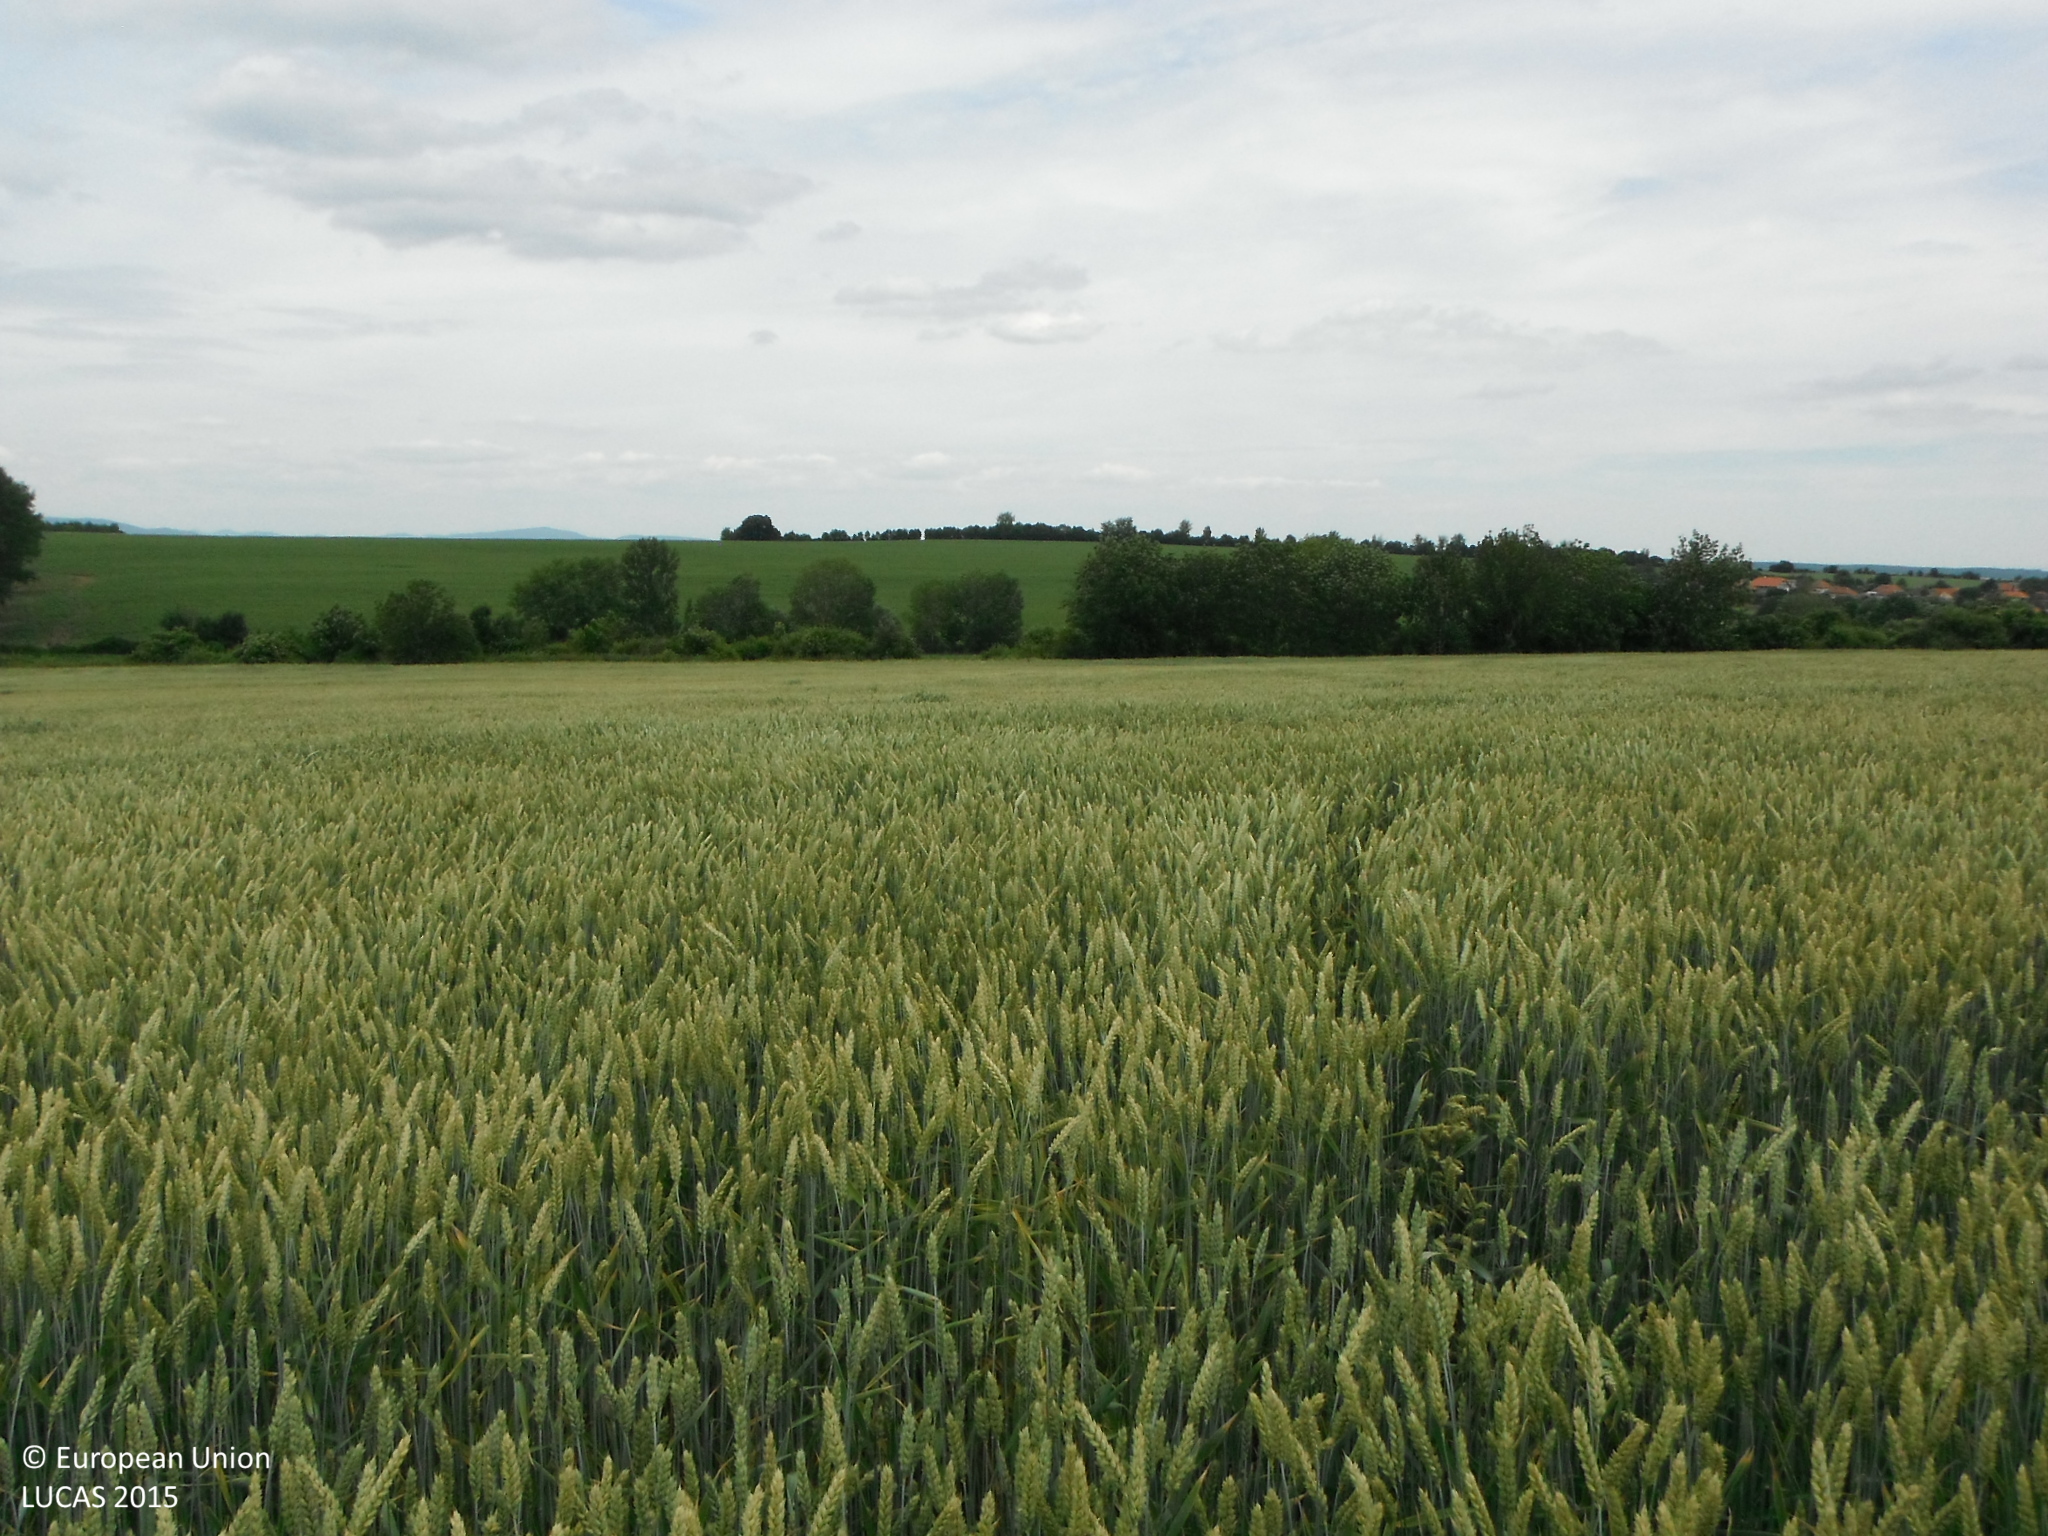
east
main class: Cropland
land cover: Common wheat
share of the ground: > 75 %
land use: Agriculture (excluding fallow land and kitchen gardens)
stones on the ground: < 10 %
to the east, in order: Common wheat; Grass margins; Shrubland without tree cover; Tracks; Shrubland without tree cover; Grass margins; Maize
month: June
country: SK
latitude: 48.3096
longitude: 18.2801
